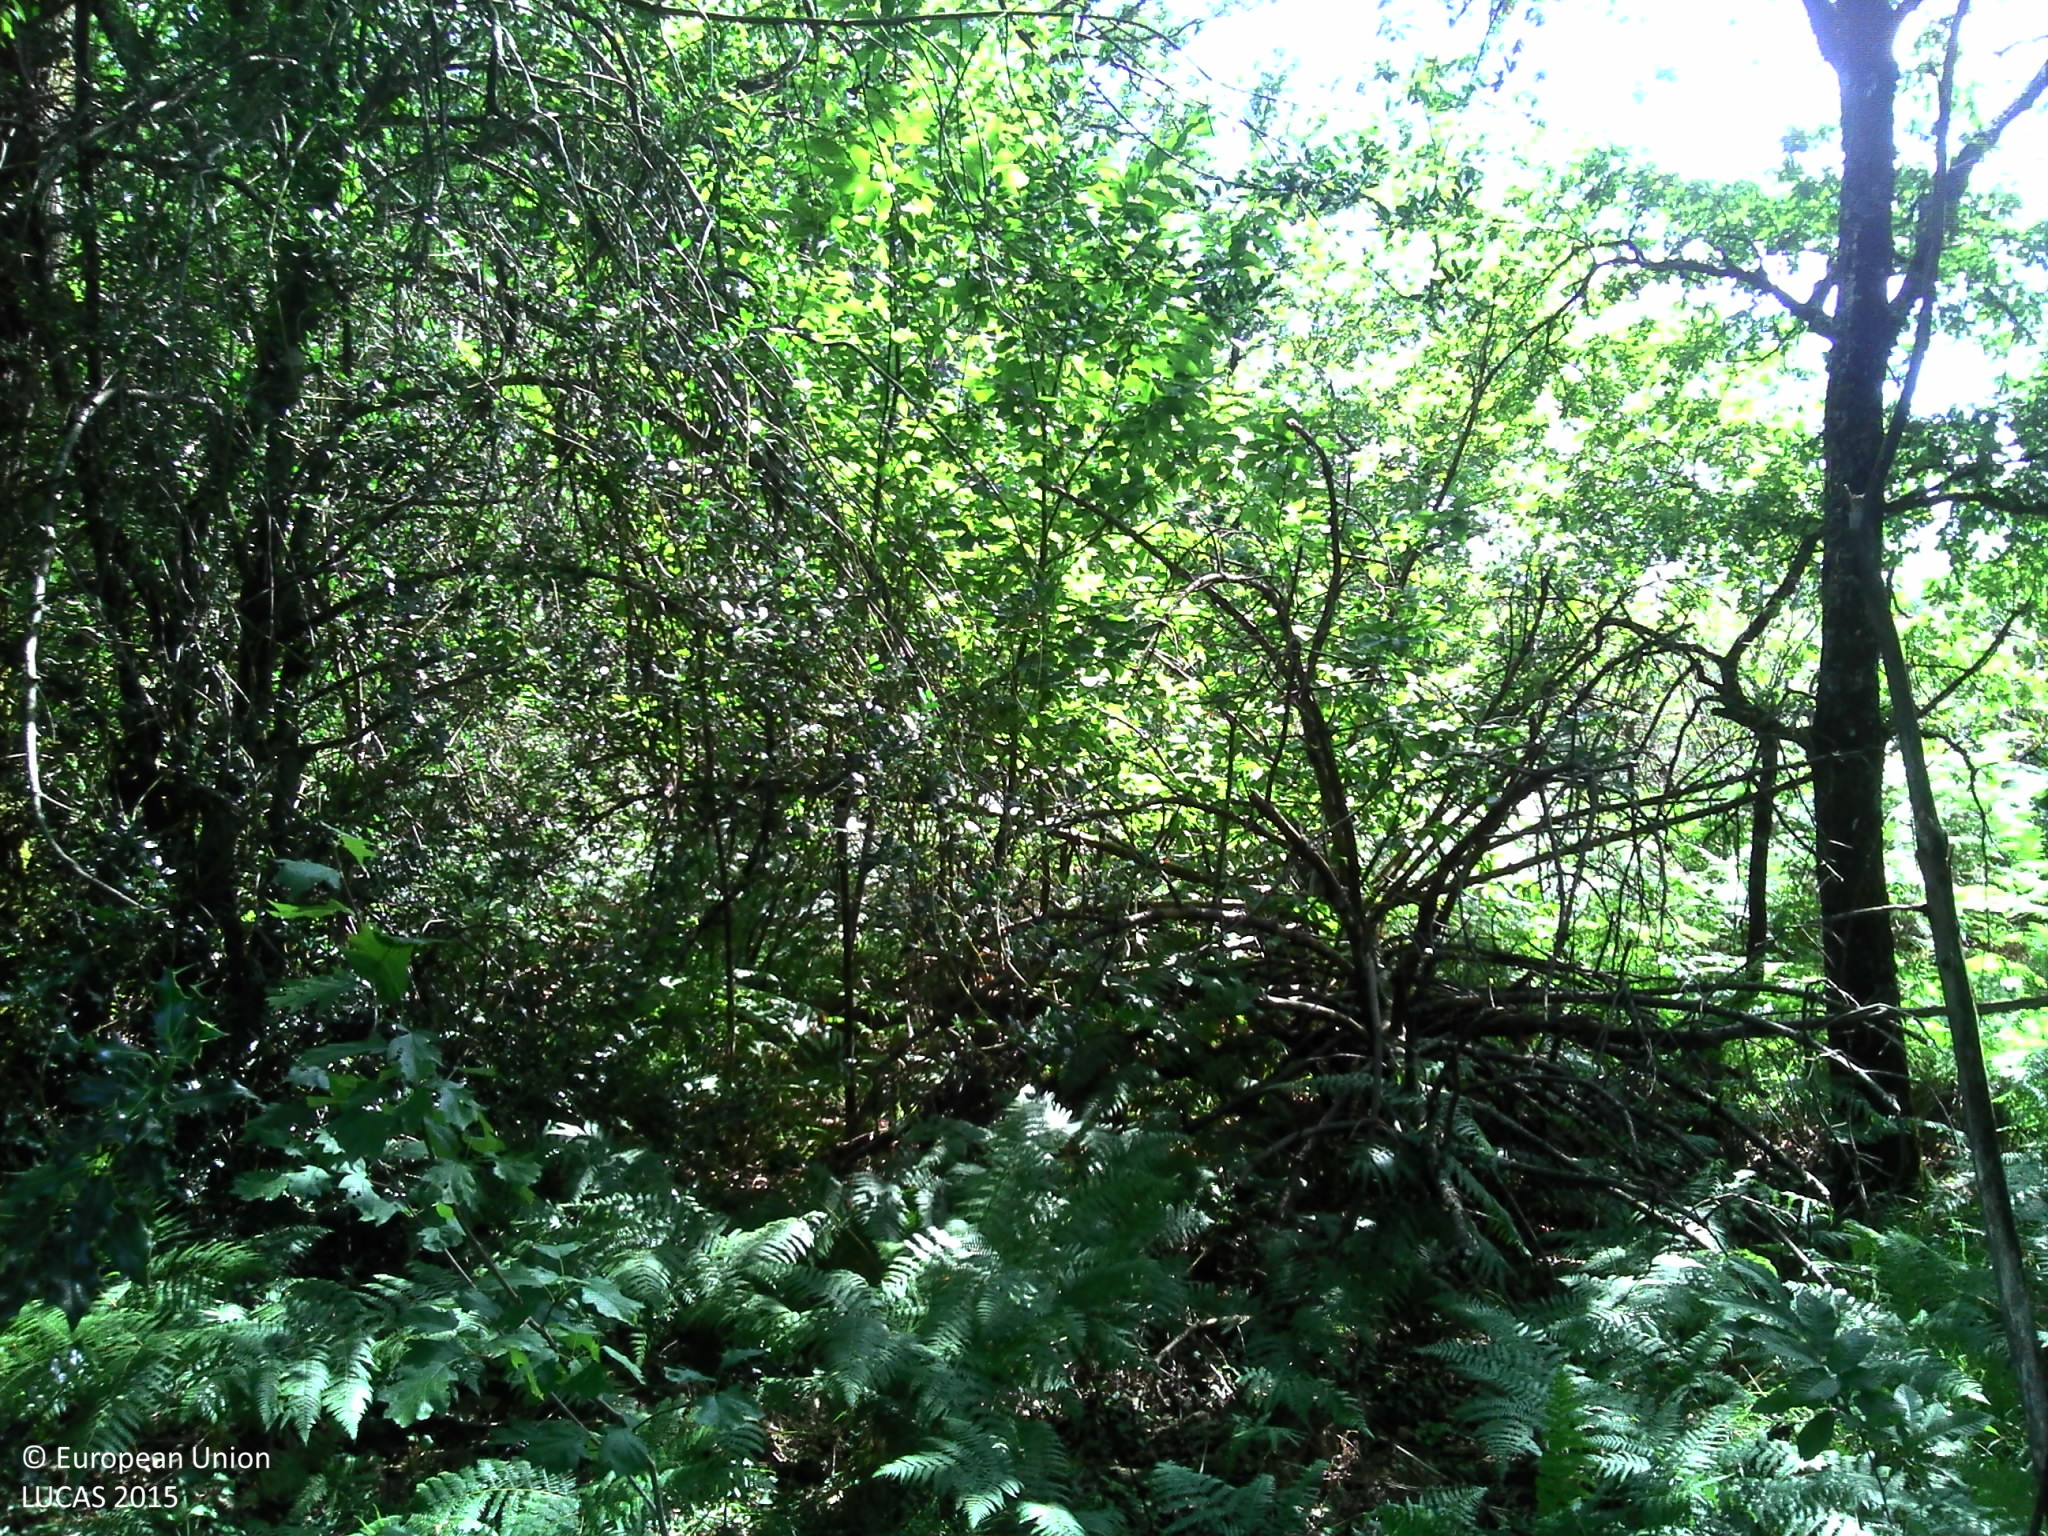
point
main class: Woodland
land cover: Broadleaved woodland
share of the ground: > 75 %
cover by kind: broadleaved forest trees 75 %, shrubs 15 %, herbaceous plants 10 %
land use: Forestry
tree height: > 5 m
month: July
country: FR
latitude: 43.8071
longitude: -0.5906
